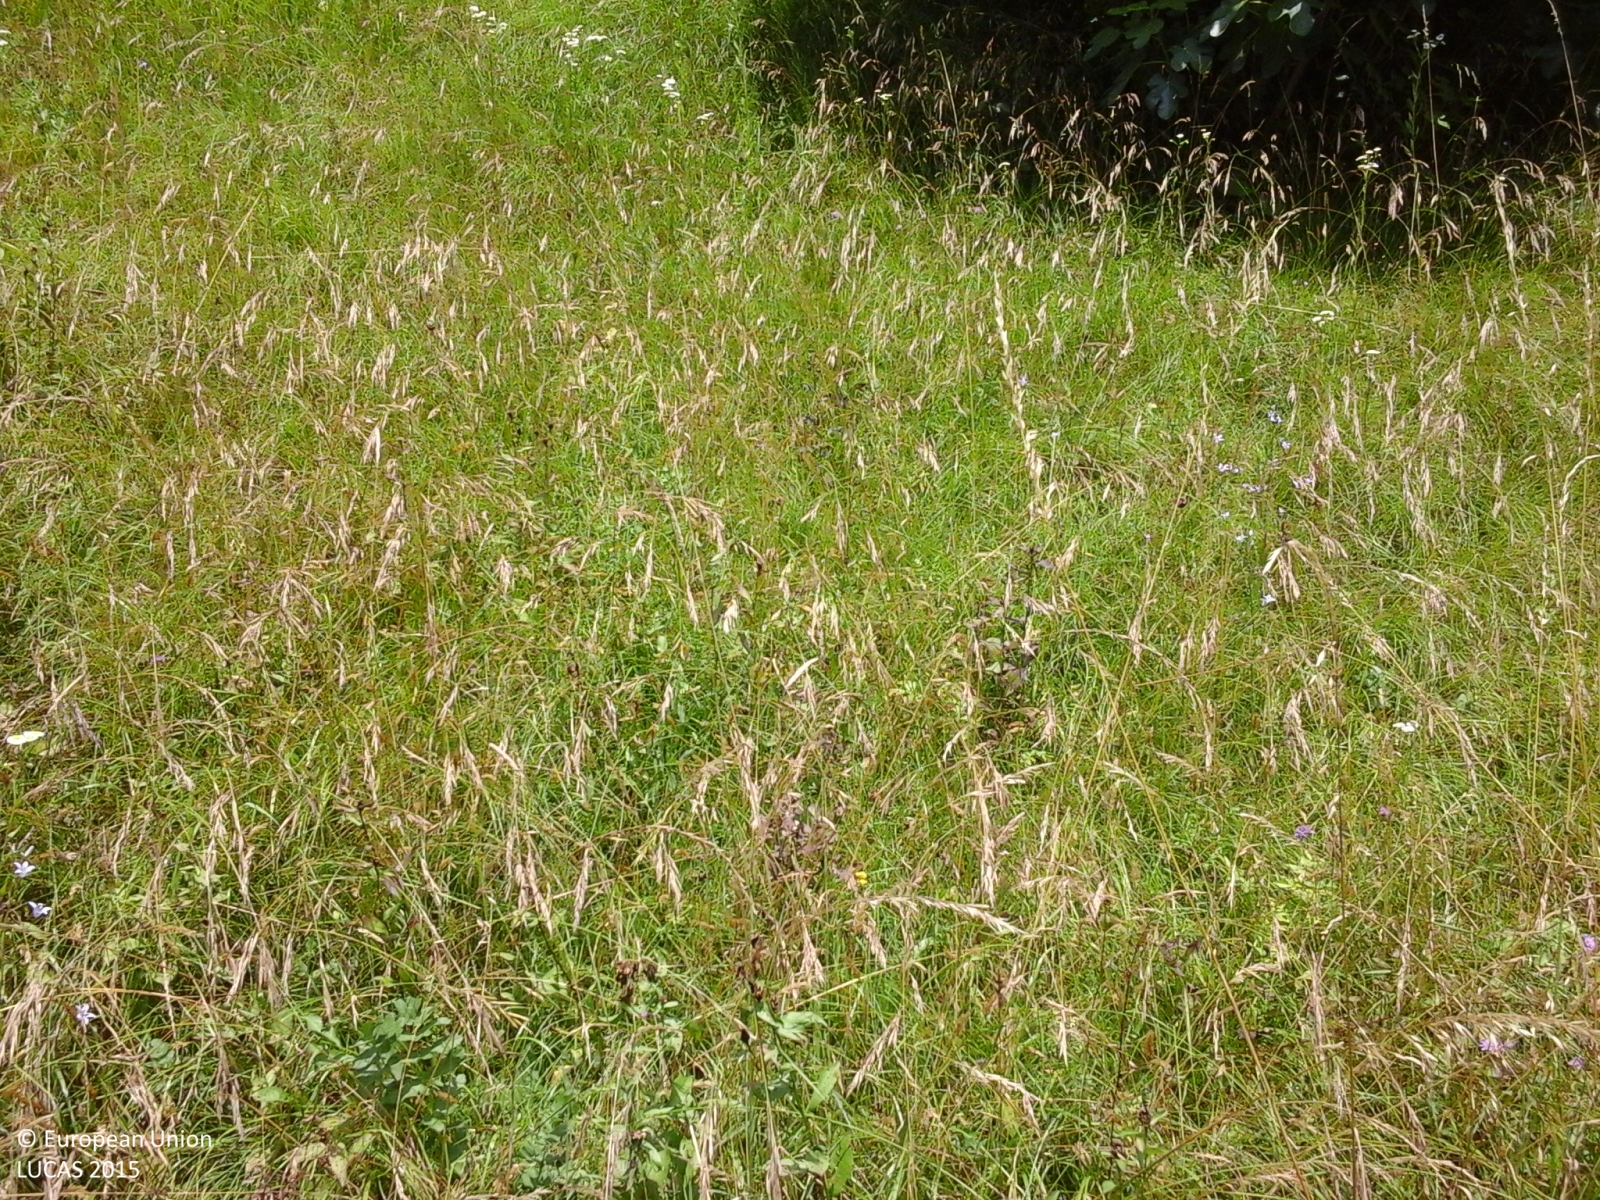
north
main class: Grassland
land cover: Grassland with sparse tree/shrub cover
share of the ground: > 75 %
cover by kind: herbaceous plants 95 %, broadleaved forest trees 5 %
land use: Agriculture (excluding fallow land and kitchen gardens)
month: June
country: IT
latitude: 45.7566
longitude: 10.1155
